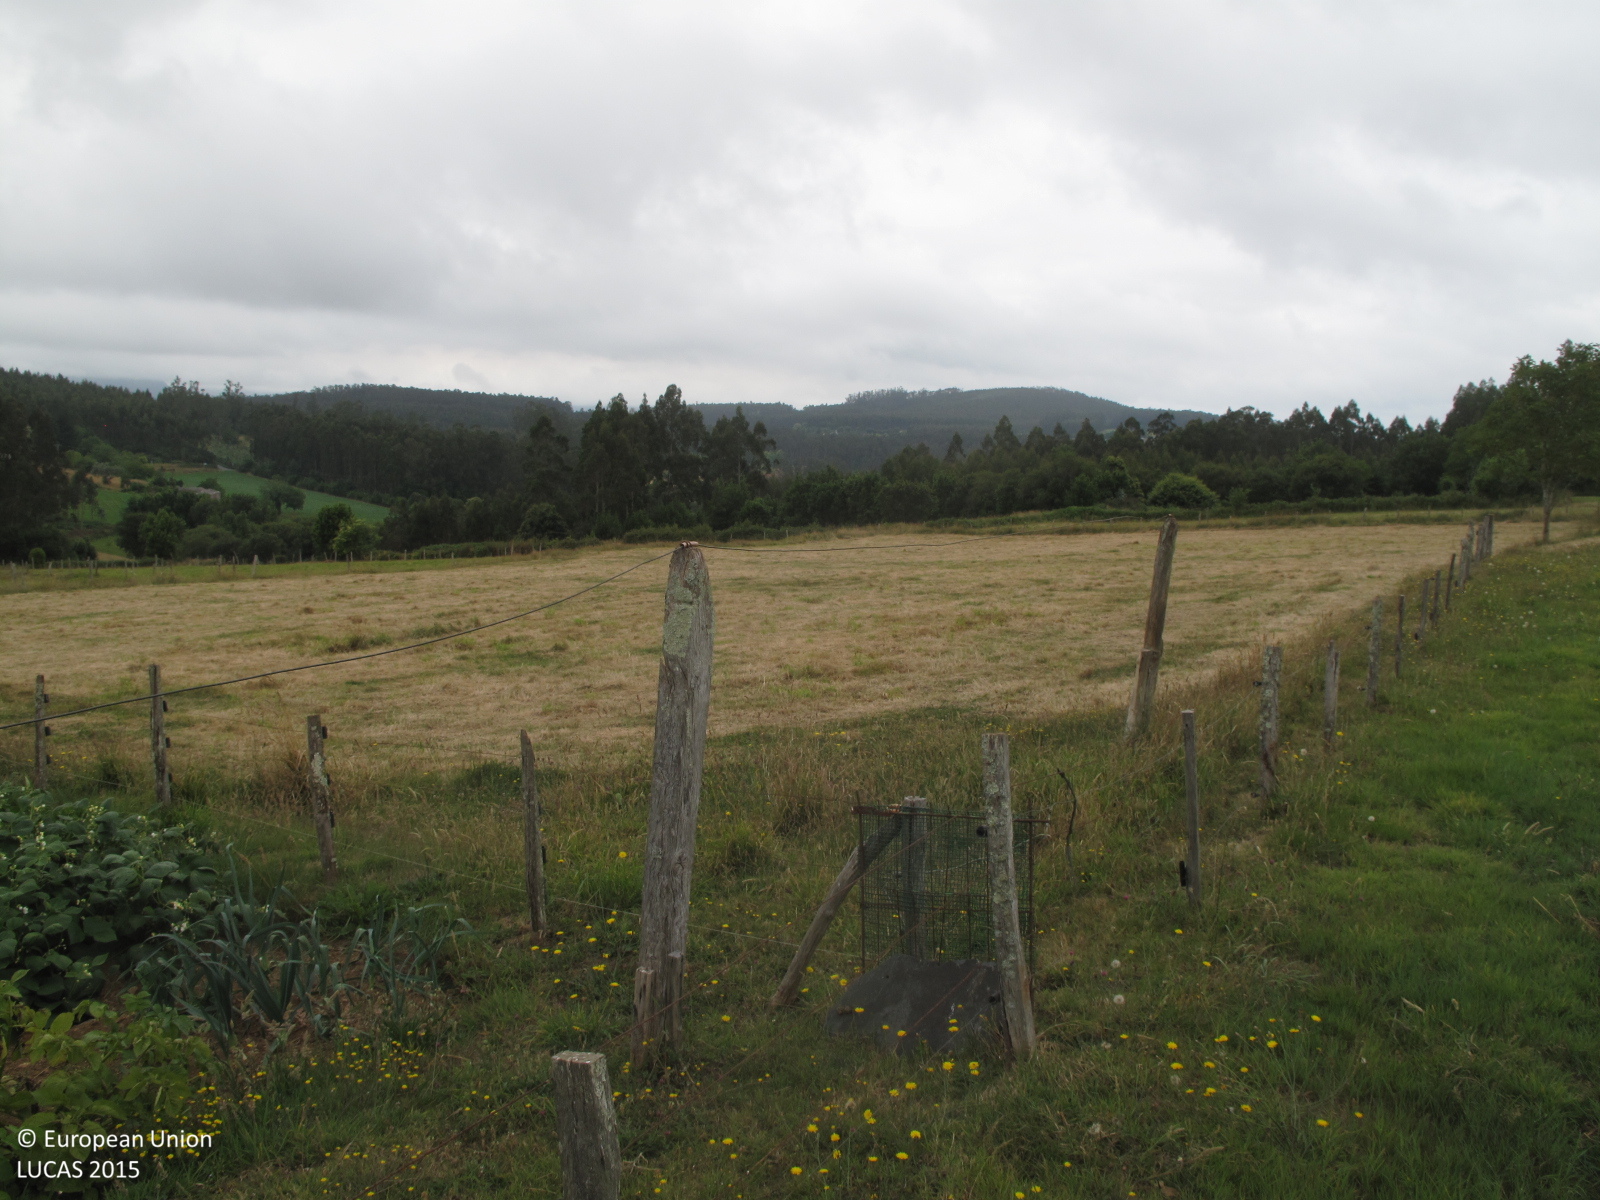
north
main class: Grassland
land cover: Grassland without tree/shrub cover
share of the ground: > 75 %
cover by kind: herbaceous plants 100 %
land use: Agriculture (excluding fallow land and kitchen gardens)
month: July
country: ES
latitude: 43.6129
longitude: -7.8742
